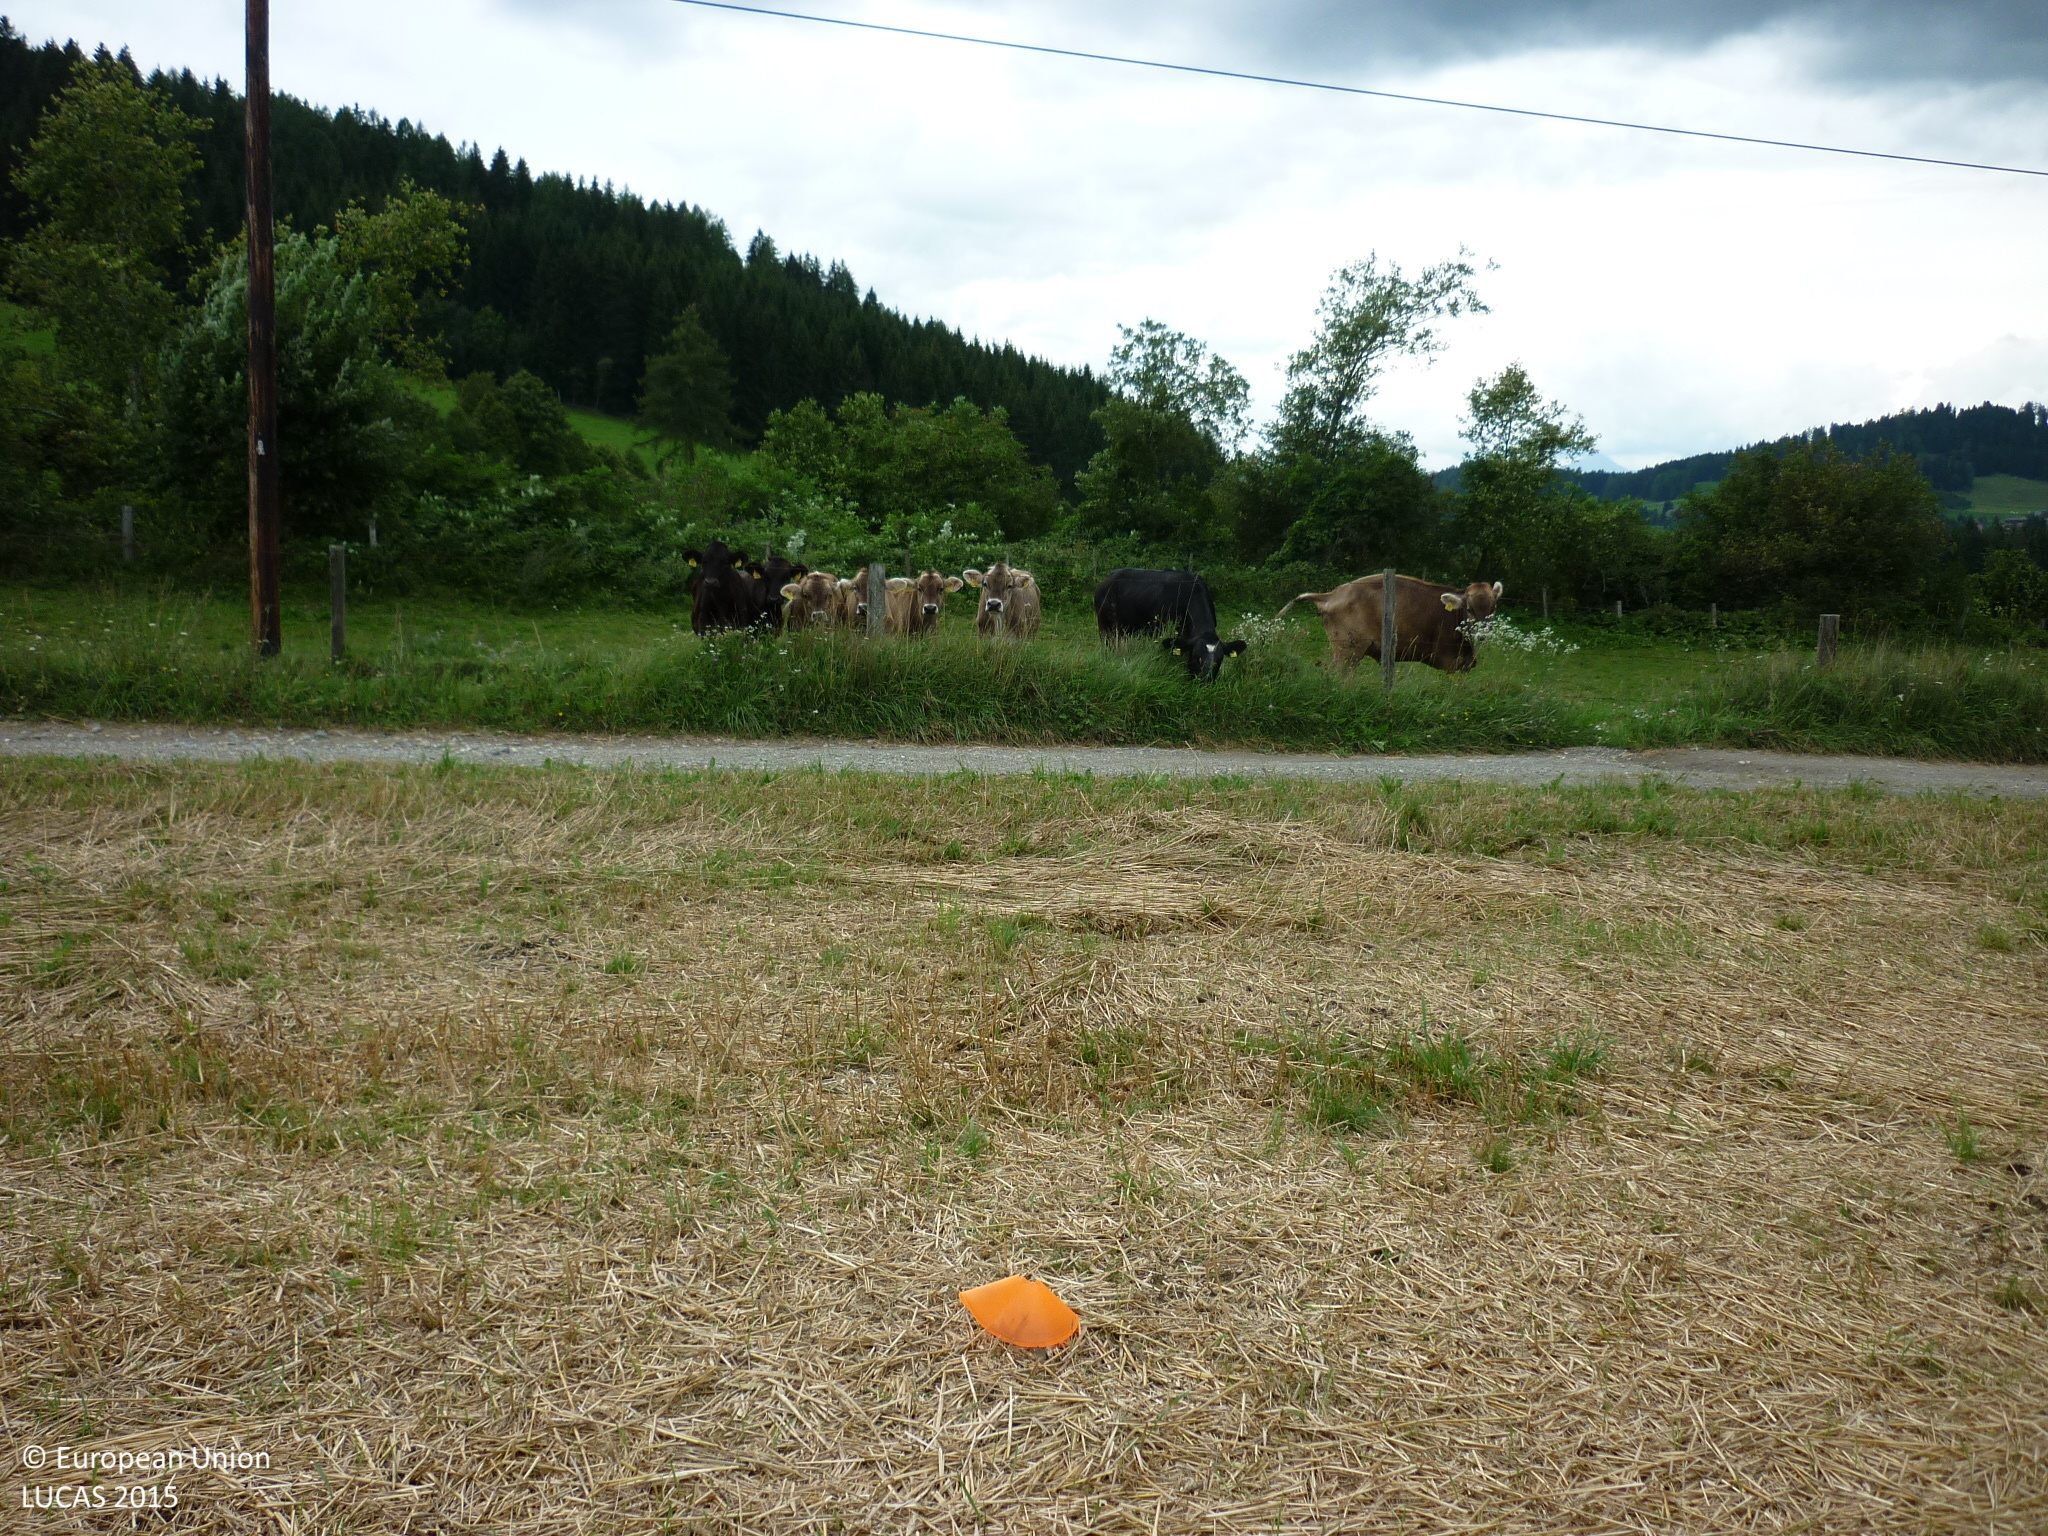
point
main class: Cropland
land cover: Common wheat
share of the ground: > 75 %
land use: Agriculture (excluding fallow land and kitchen gardens)
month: August
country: AT
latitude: 47.0147
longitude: 14.4841
